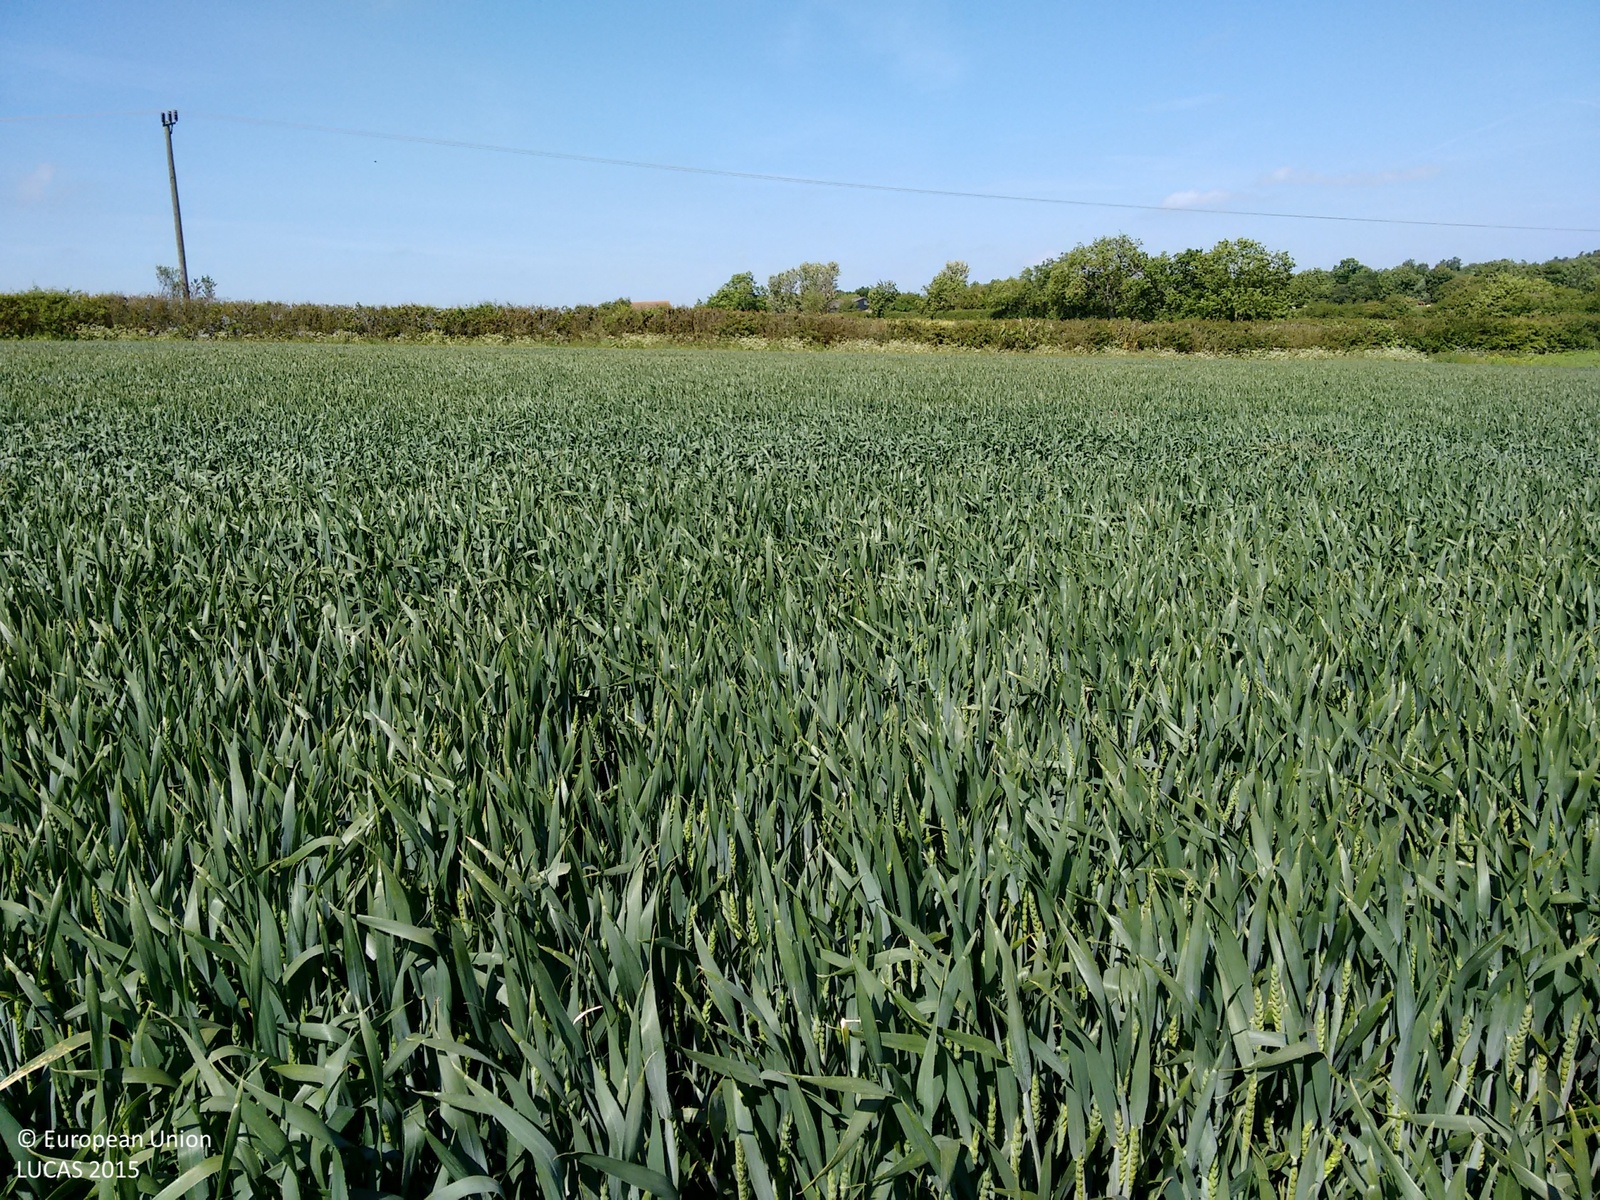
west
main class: Cropland
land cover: Common wheat
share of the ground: > 75 %
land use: Agriculture (excluding fallow land and kitchen gardens)
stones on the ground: 10 - 25 %
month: June
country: GB
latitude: 52.8654
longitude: -0.5704
